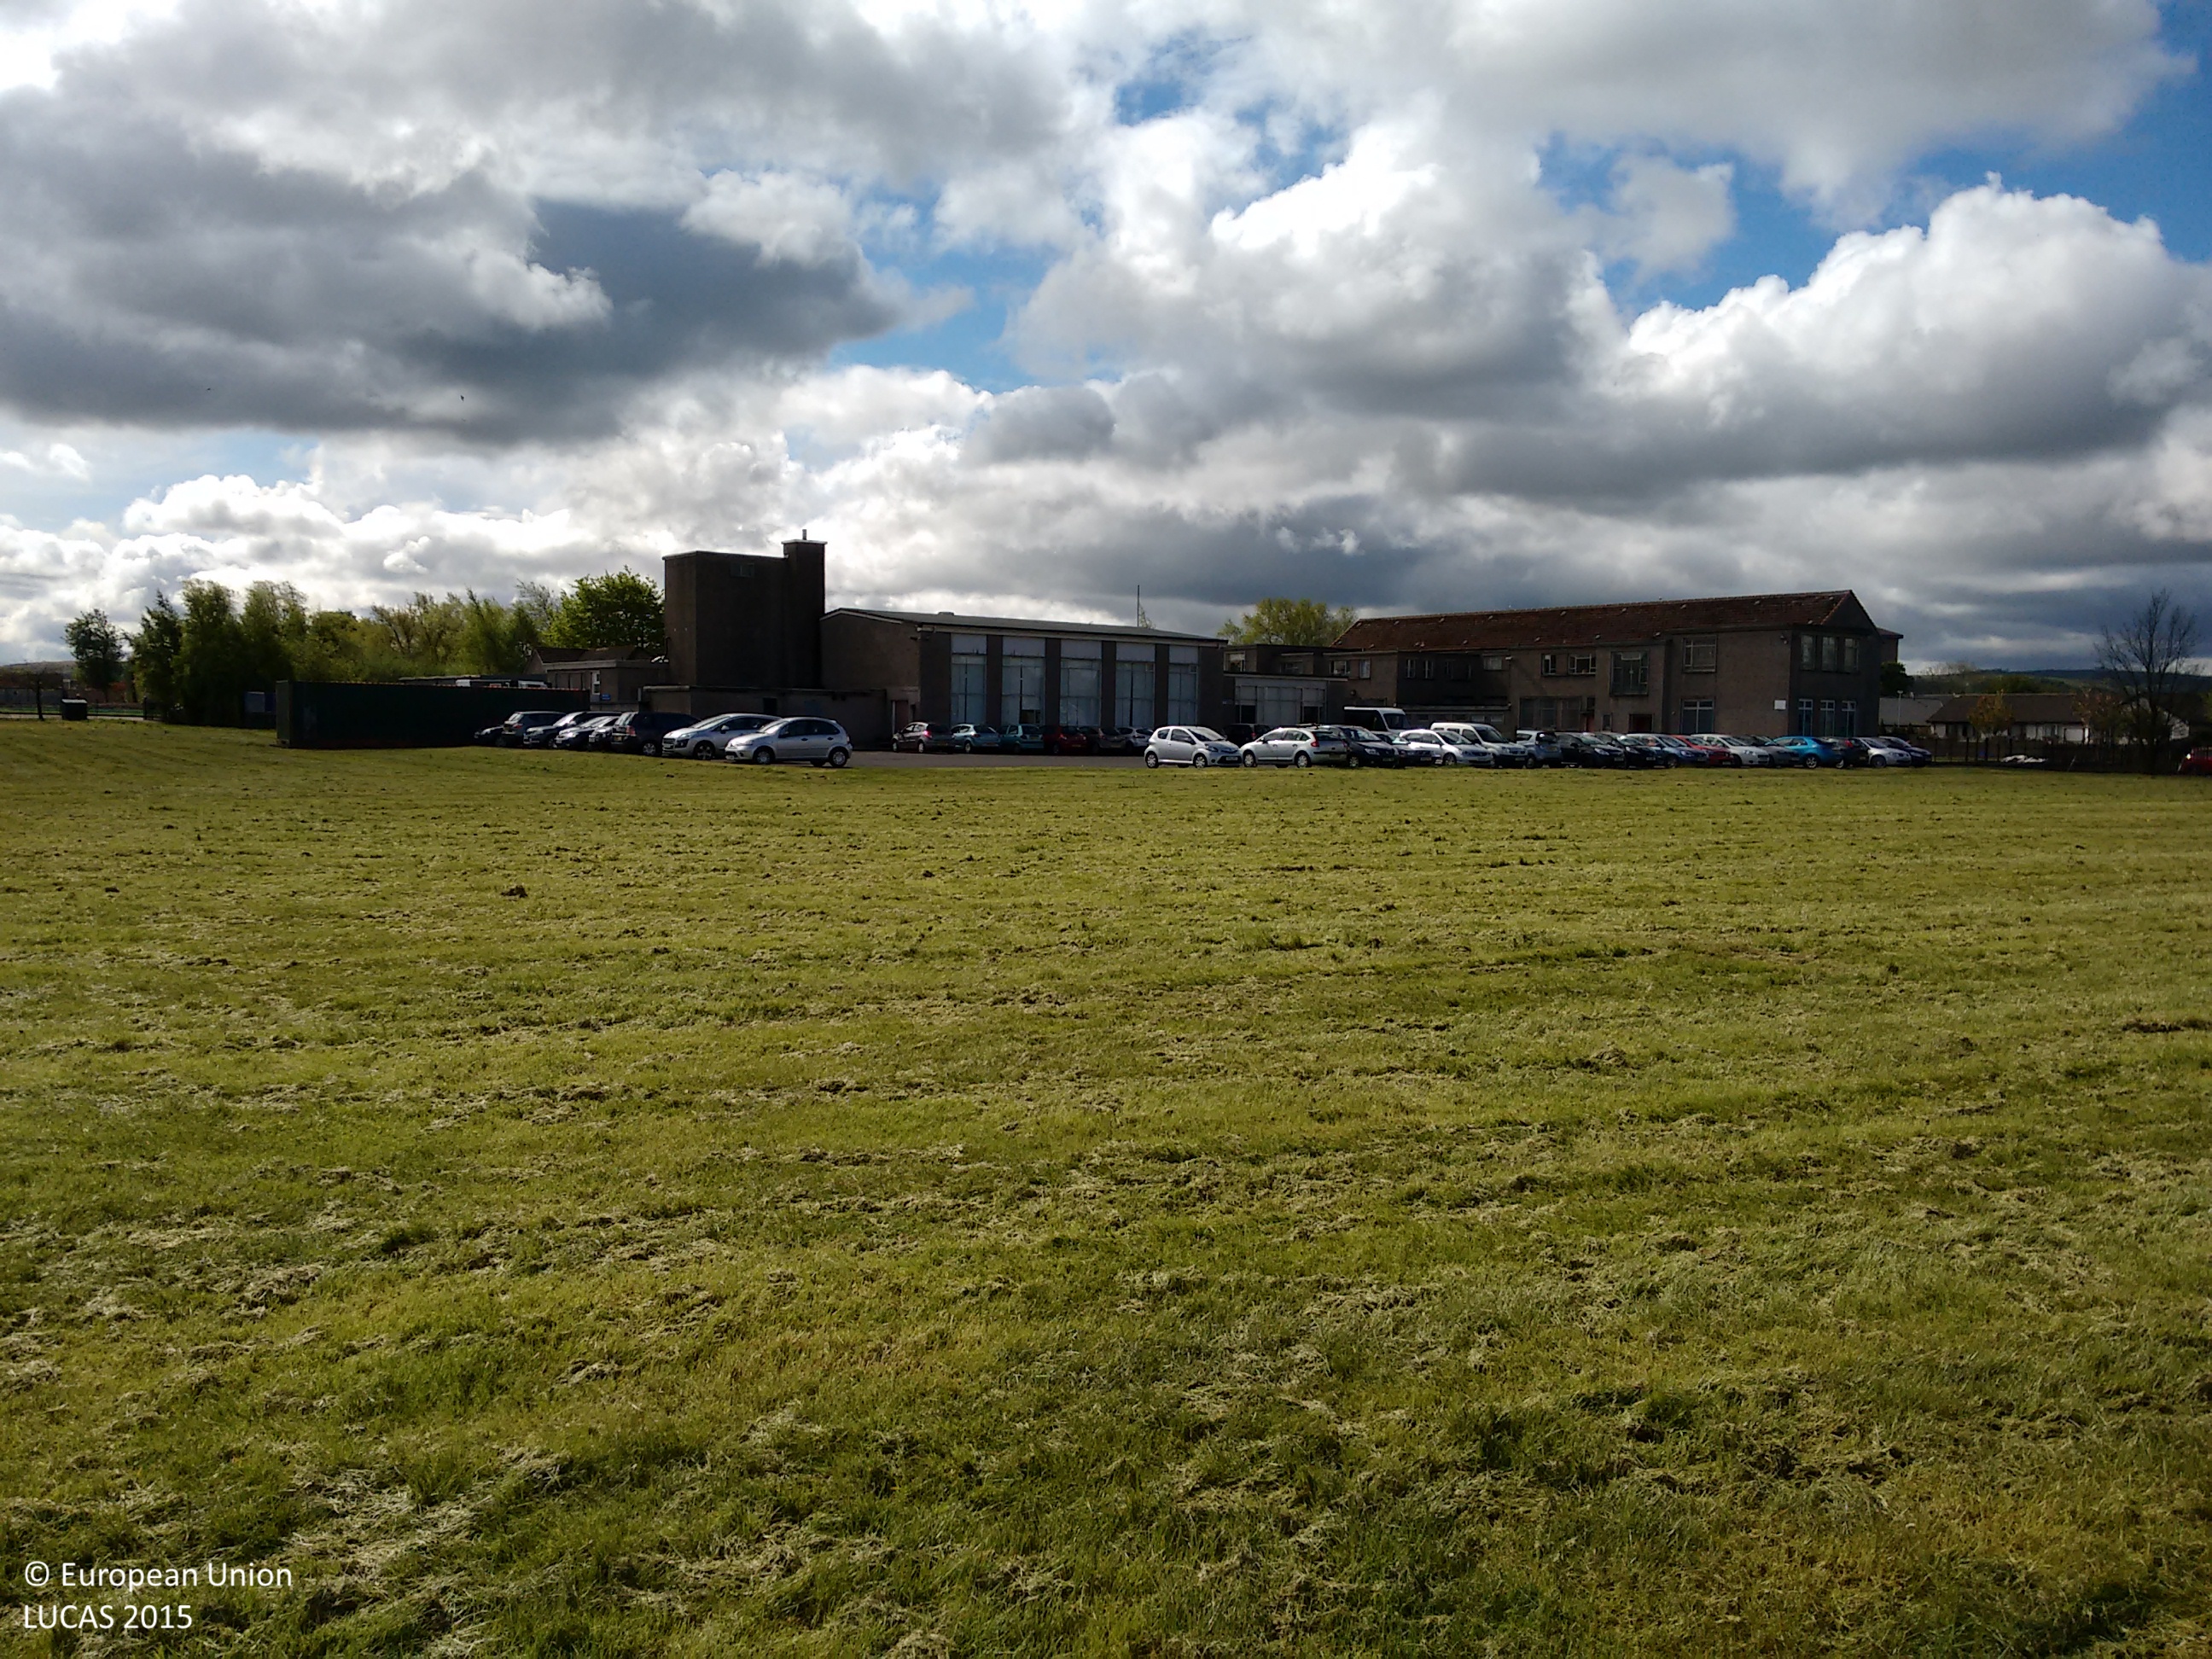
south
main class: Grassland
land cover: Grassland without tree/shrub cover
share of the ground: > 75 %
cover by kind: herbaceous plants 100 %
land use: Sport
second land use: Community services
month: May
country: GB
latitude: 55.8531
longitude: -4.4912
